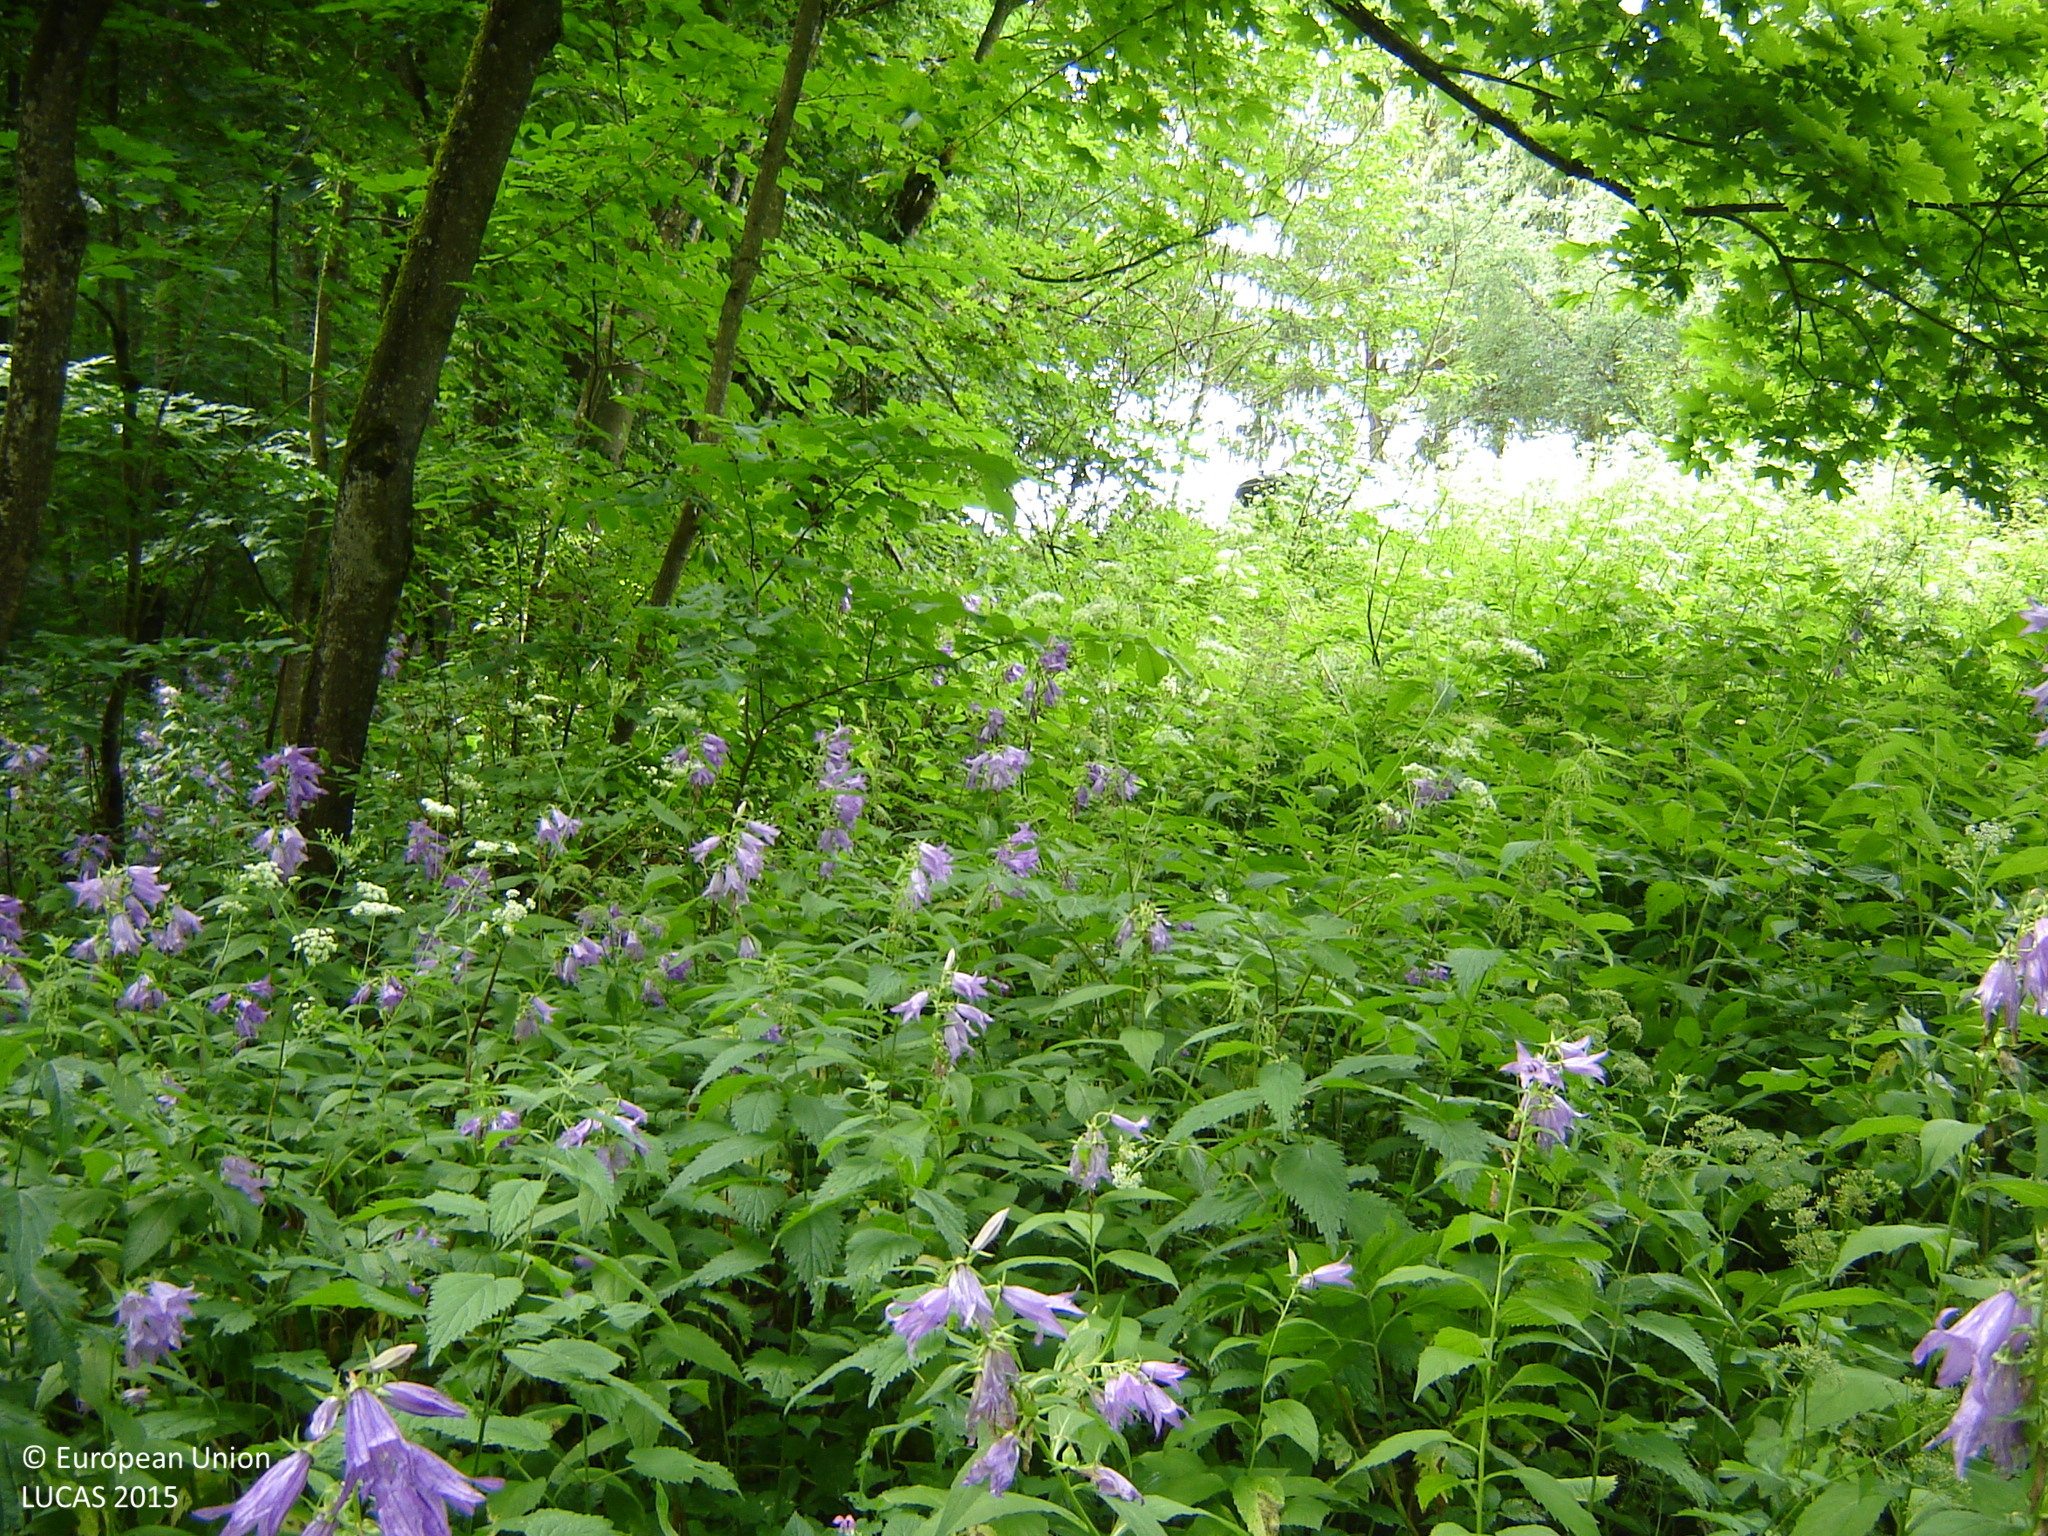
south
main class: Woodland
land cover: Broadleaved woodland
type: floodplain forest
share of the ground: > 75 %
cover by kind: broadleaved forest trees 75 %, herbaceous plants 25 %
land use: Forestry
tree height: > 5 m
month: July
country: LT
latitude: 55.3680
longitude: 25.1847
